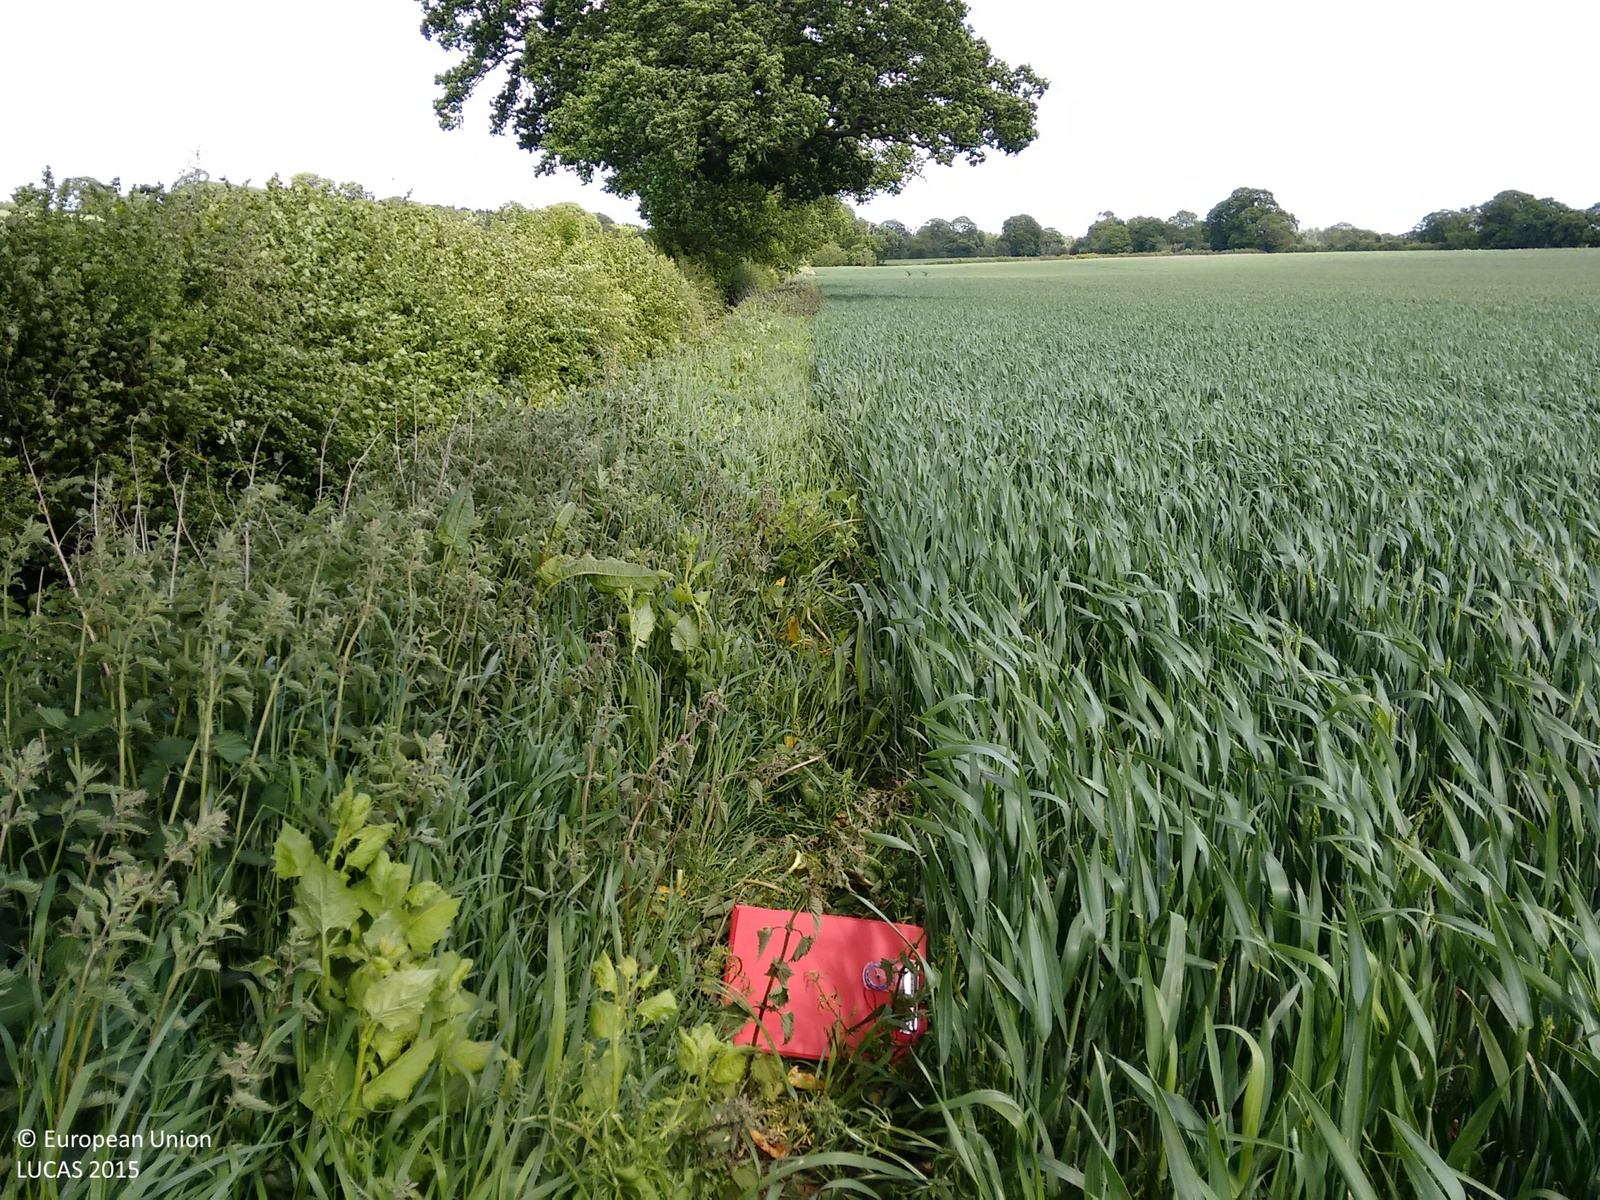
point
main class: Cropland
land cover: Common wheat
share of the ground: > 75 %
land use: Agriculture (excluding fallow land and kitchen gardens)
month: June
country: GB
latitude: 52.5041
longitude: -1.5277
